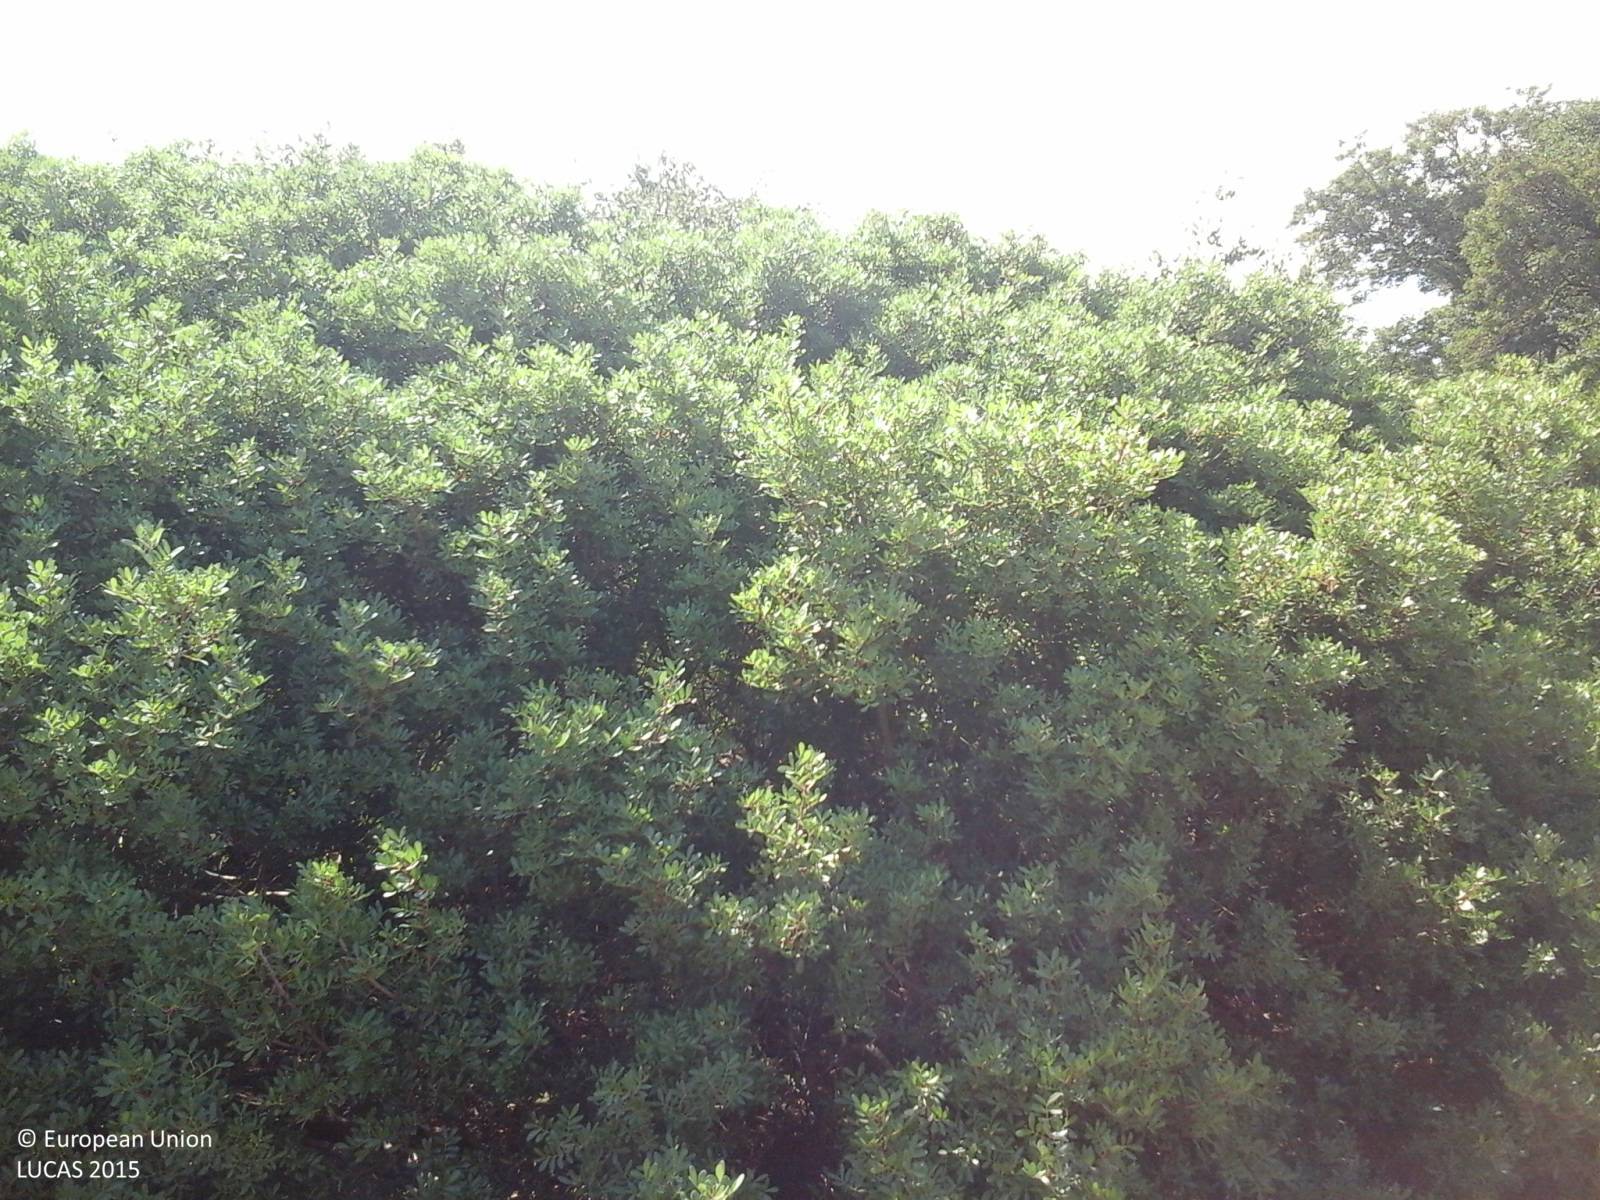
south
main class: Shrubland
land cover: Shrubland without tree cover
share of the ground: > 75 %
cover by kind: shrubs 90 %, herbaceous plants 5 %
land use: Agriculture (excluding fallow land and kitchen gardens)
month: September
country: IT
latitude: 41.0969
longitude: 9.2533
